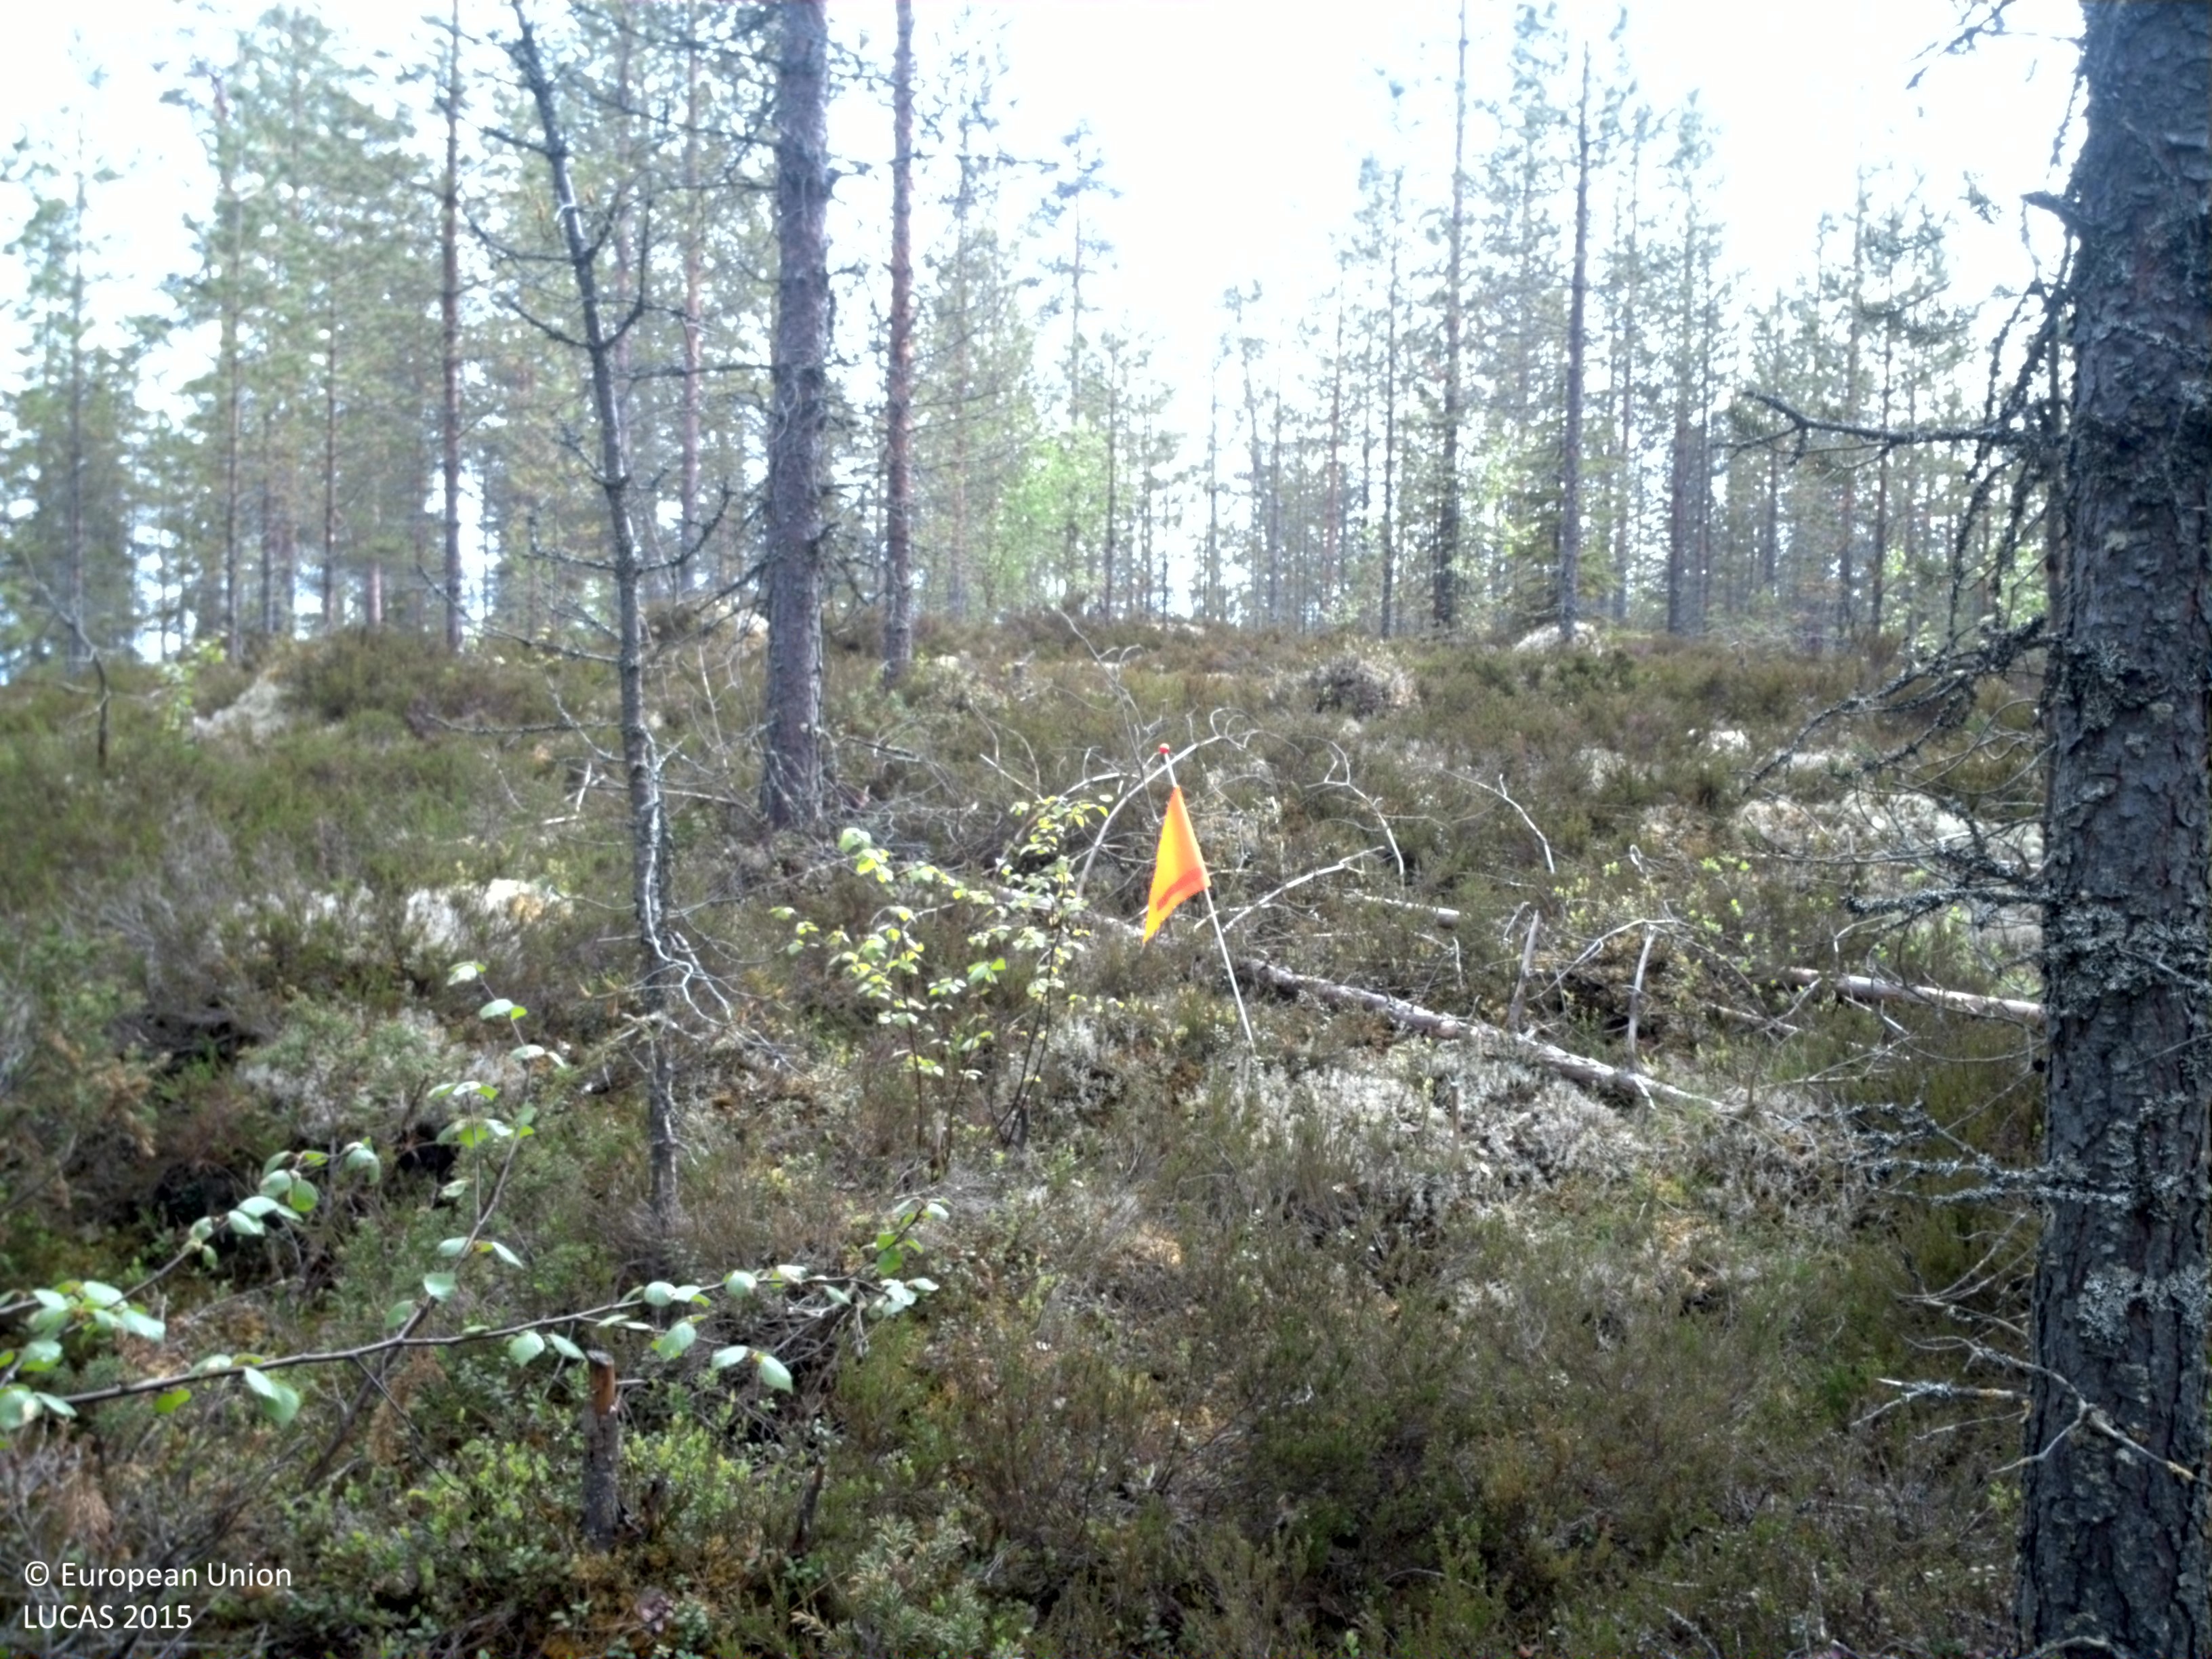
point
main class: Woodland
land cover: Pine dominated coniferous woodland
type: boreal forest
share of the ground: 25 - 50 %
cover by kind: coniferous forest trees 40 %, lichens and mosses 35 %, herbaceous plants 25 %
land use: Forestry
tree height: > 5 m
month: June
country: SE
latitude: 61.3795
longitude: 13.5619
